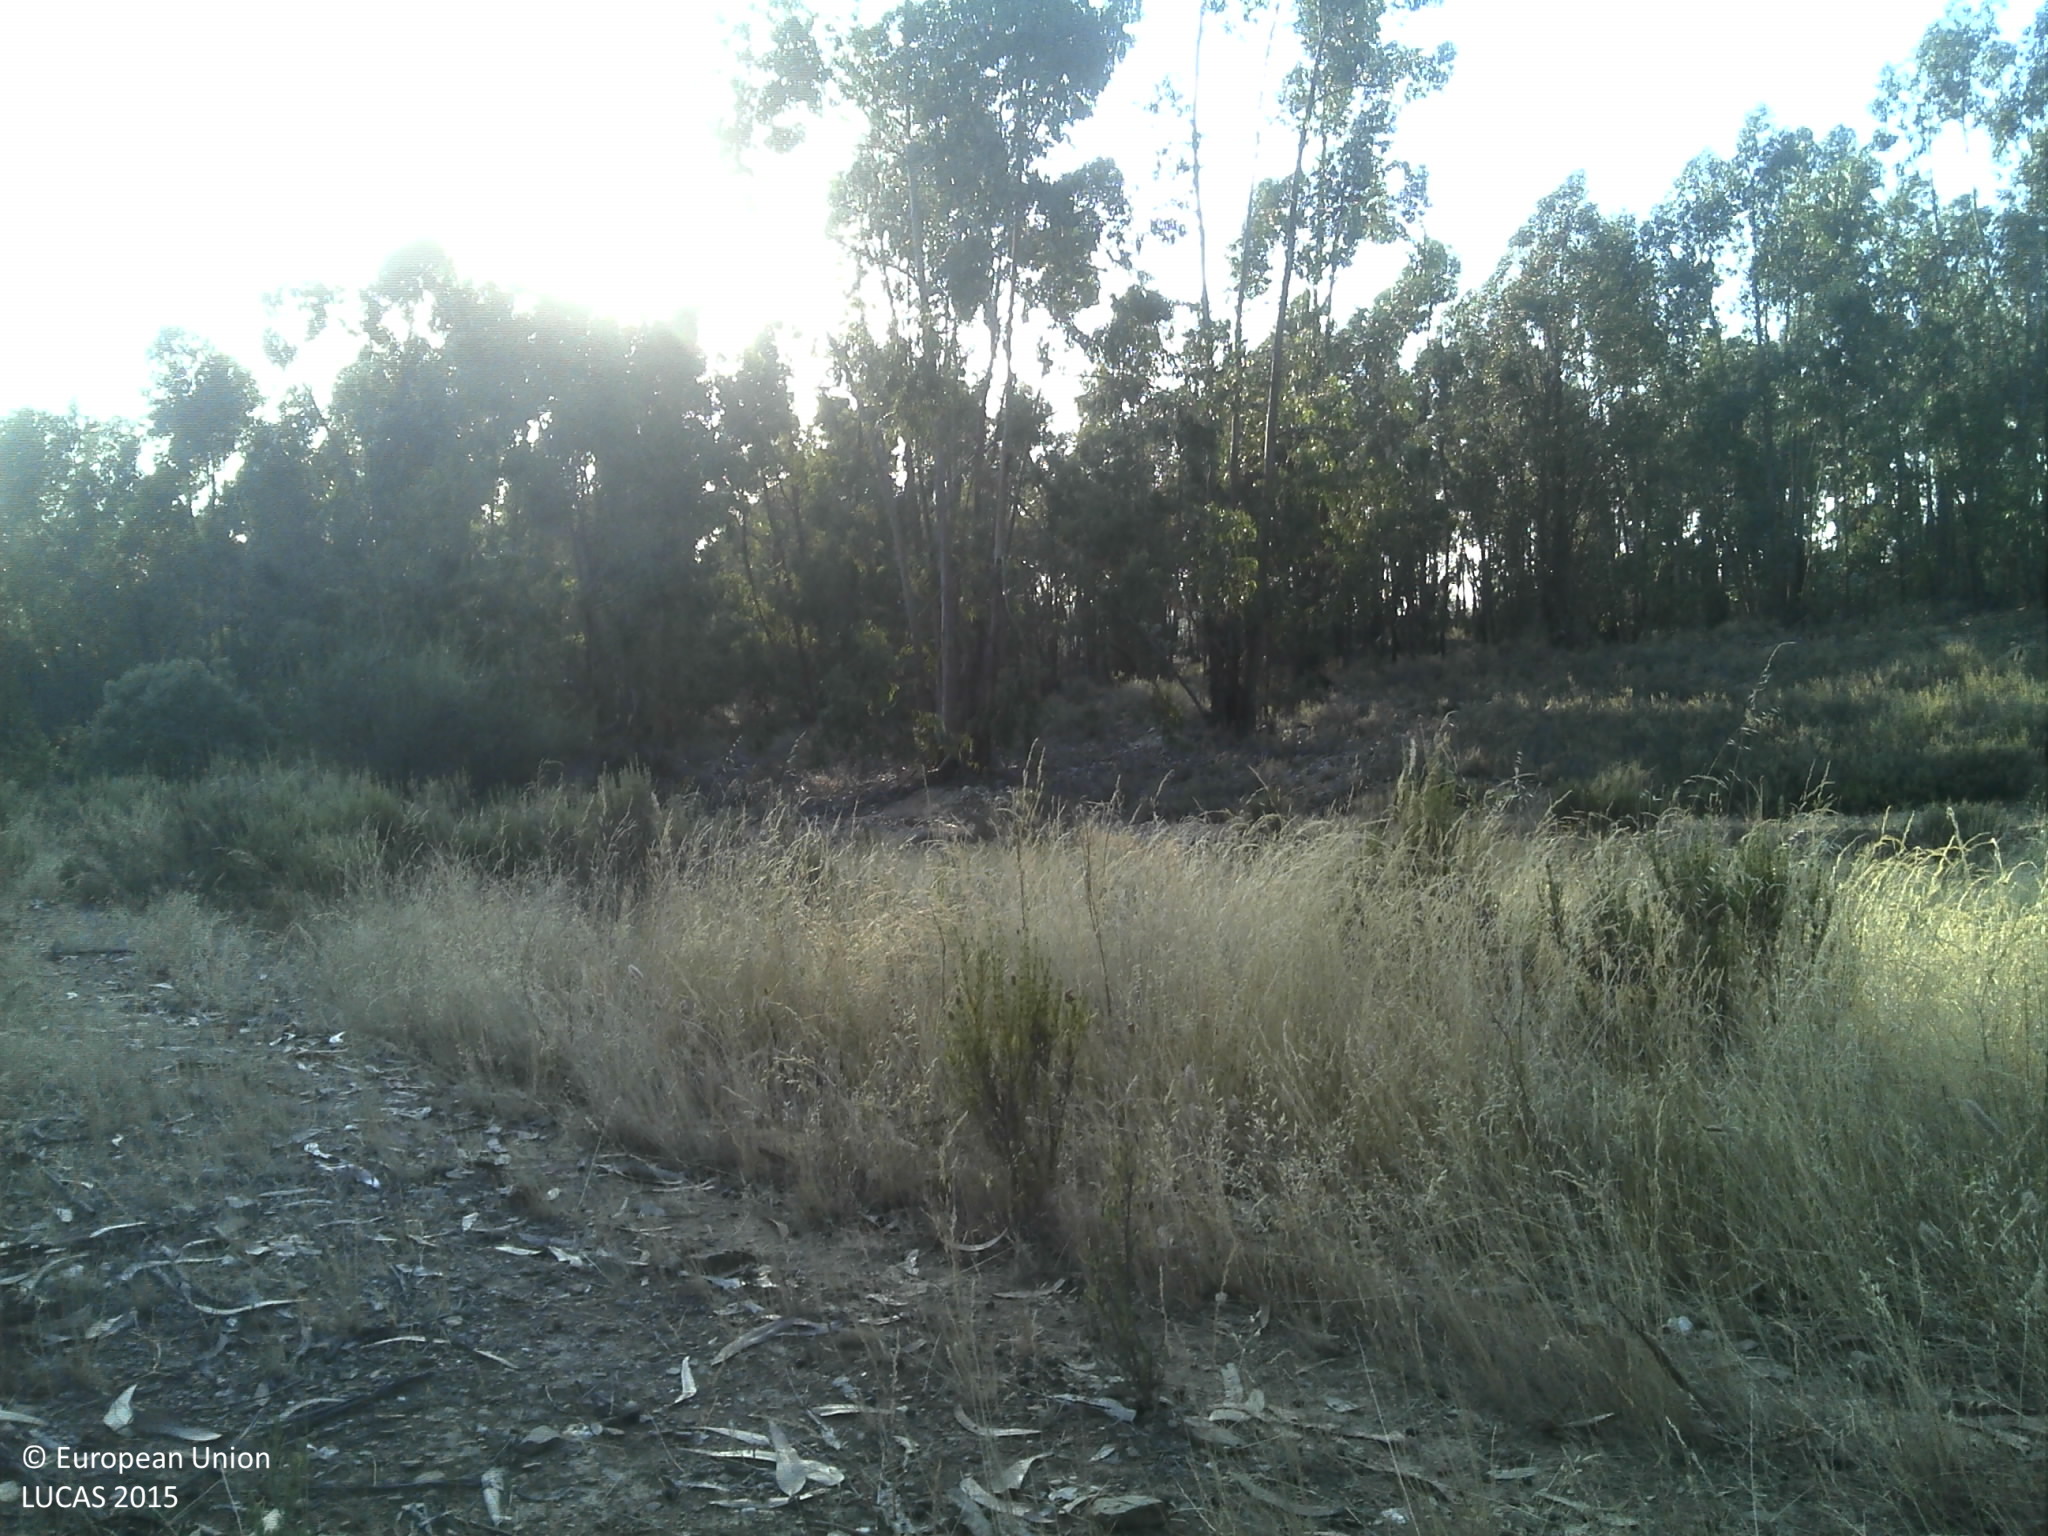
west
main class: Woodland
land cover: Broadleaved woodland
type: exotic forest
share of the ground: 25 - 50 %
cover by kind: unconsolidated bare surface 50 %, broadleaved forest trees 35 %, shrubs 5 %, herbaceous plants 5 %
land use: Forestry
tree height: > 5 m
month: June
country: PT
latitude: 39.9902
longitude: -6.9899
